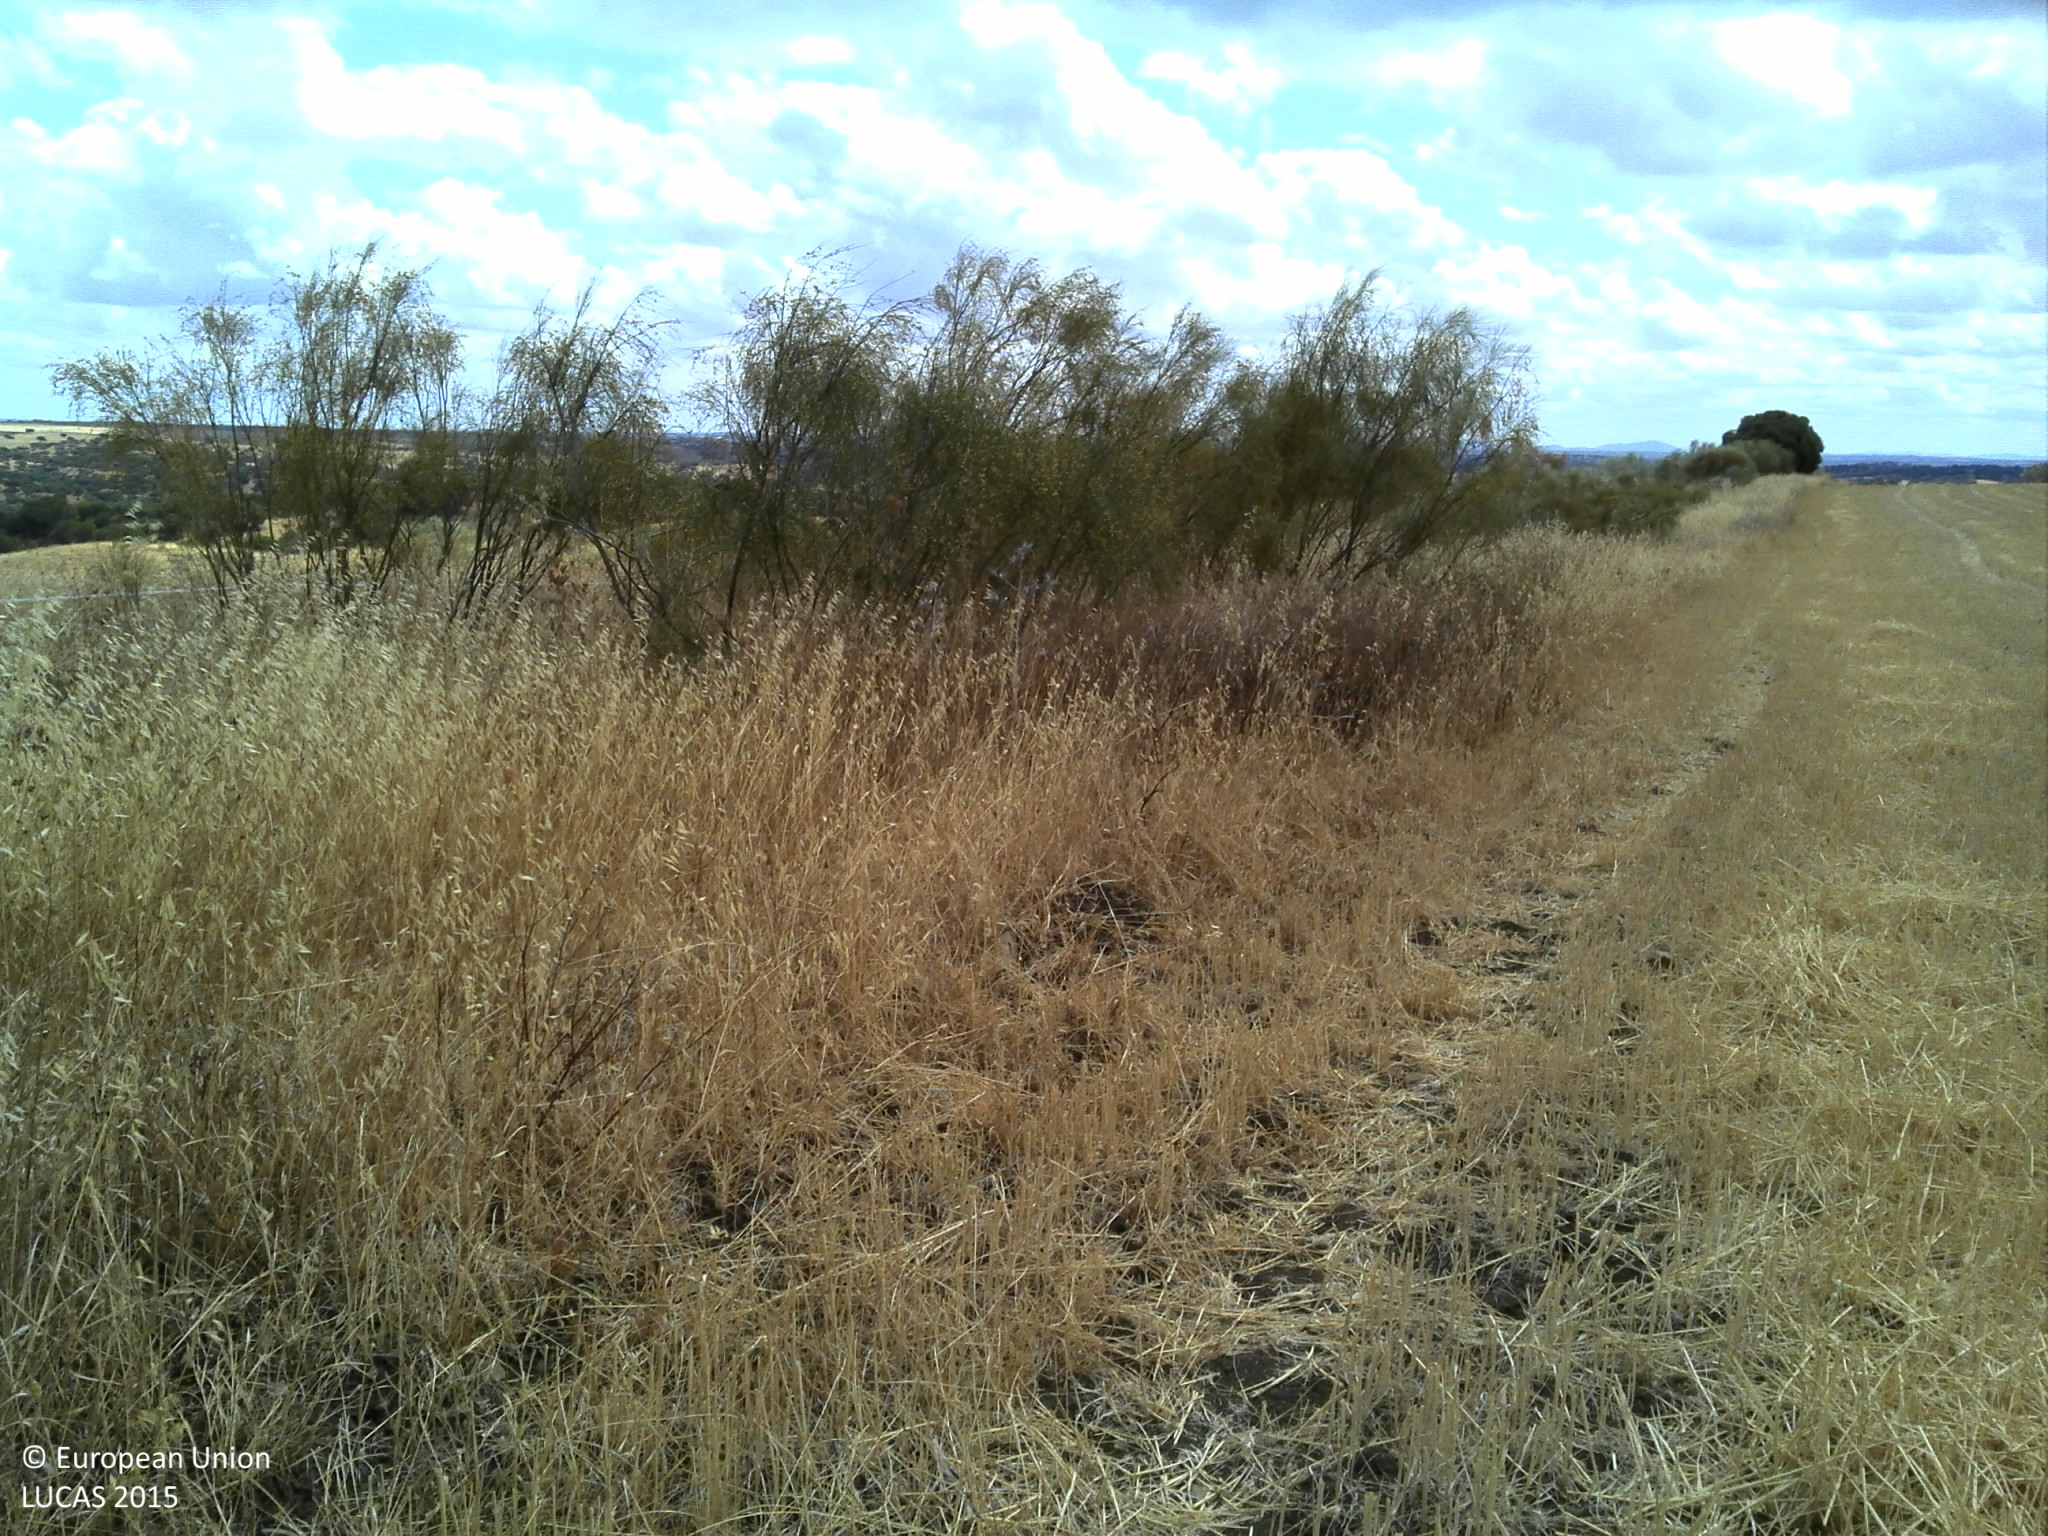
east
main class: Cropland
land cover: Common wheat
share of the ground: > 75 %
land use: Agriculture (excluding fallow land and kitchen gardens)
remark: Harvested field
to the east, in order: Common wheat; Shrubland without tree cover; Grass margins; Tracks; Fences; Other structural elements; Grassland without tree/shrub cover
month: July
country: PT
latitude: 38.1049
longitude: -7.7140
